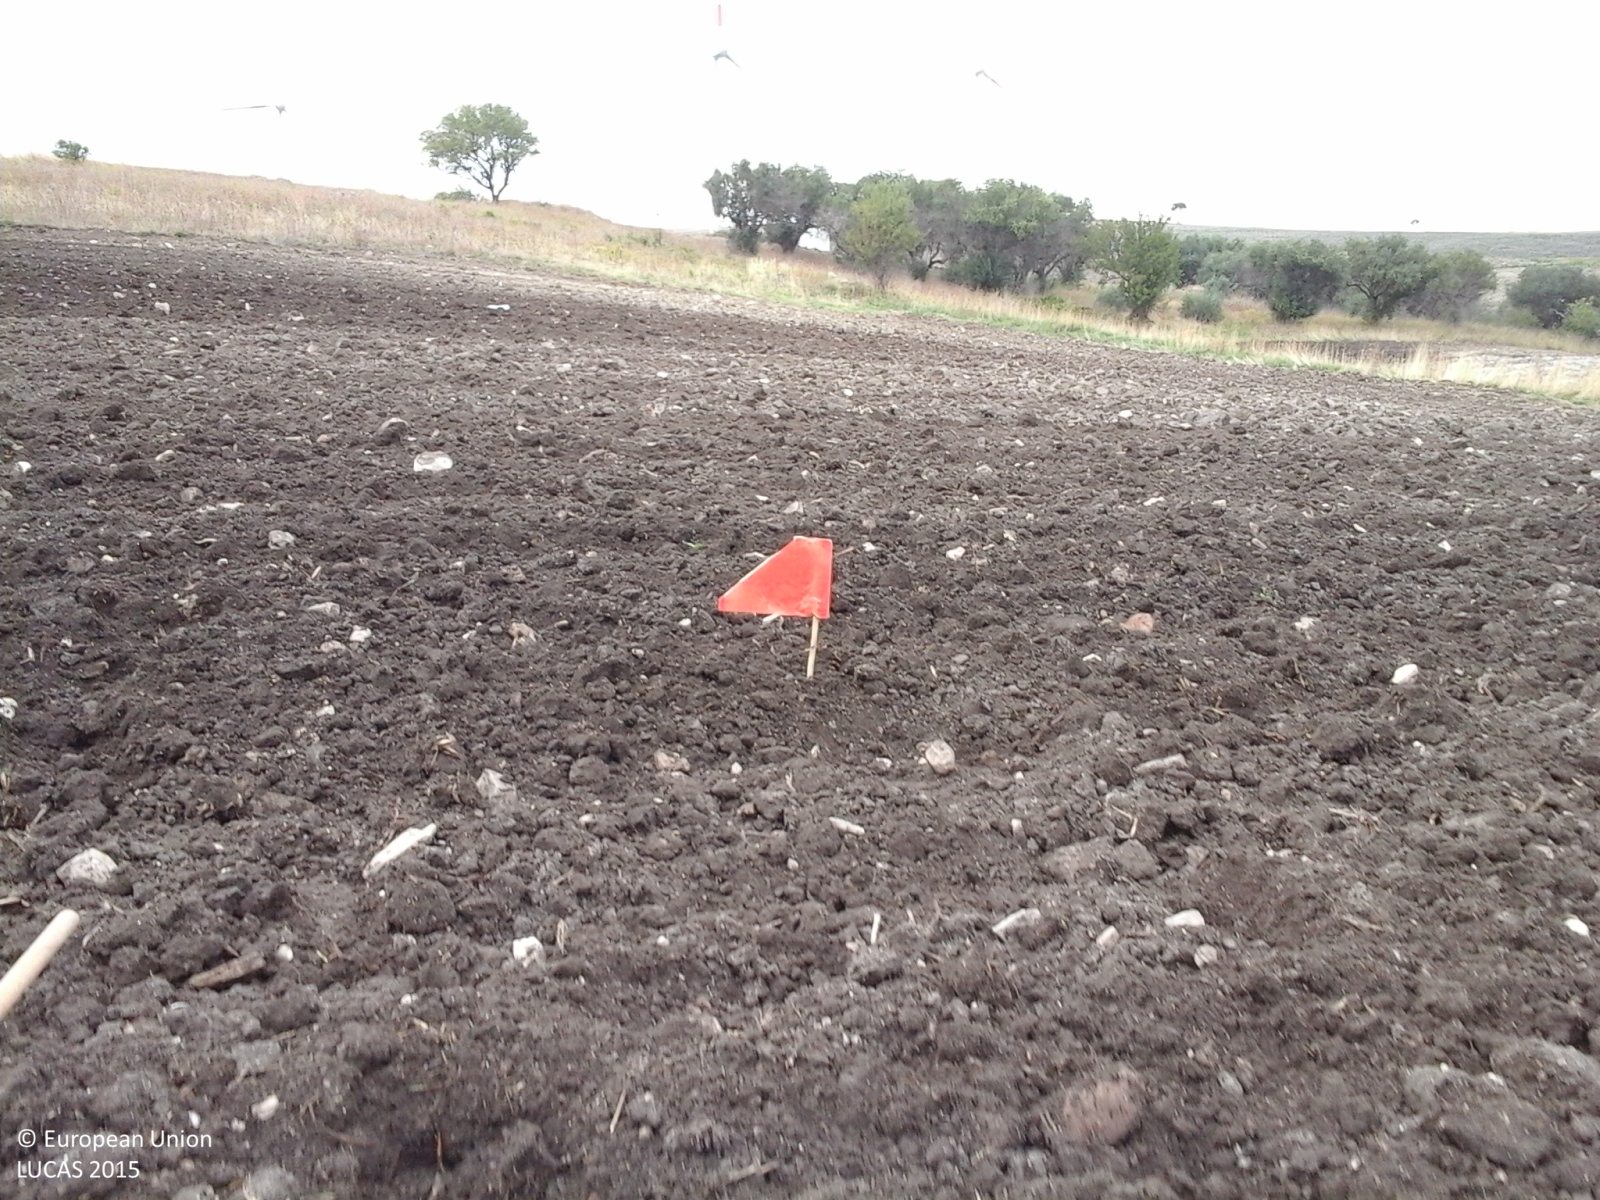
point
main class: Cropland
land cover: Durum wheat
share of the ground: > 75 %
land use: Agriculture (excluding fallow land and kitchen gardens)
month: October
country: IT
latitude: 41.5636
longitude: 15.1511
